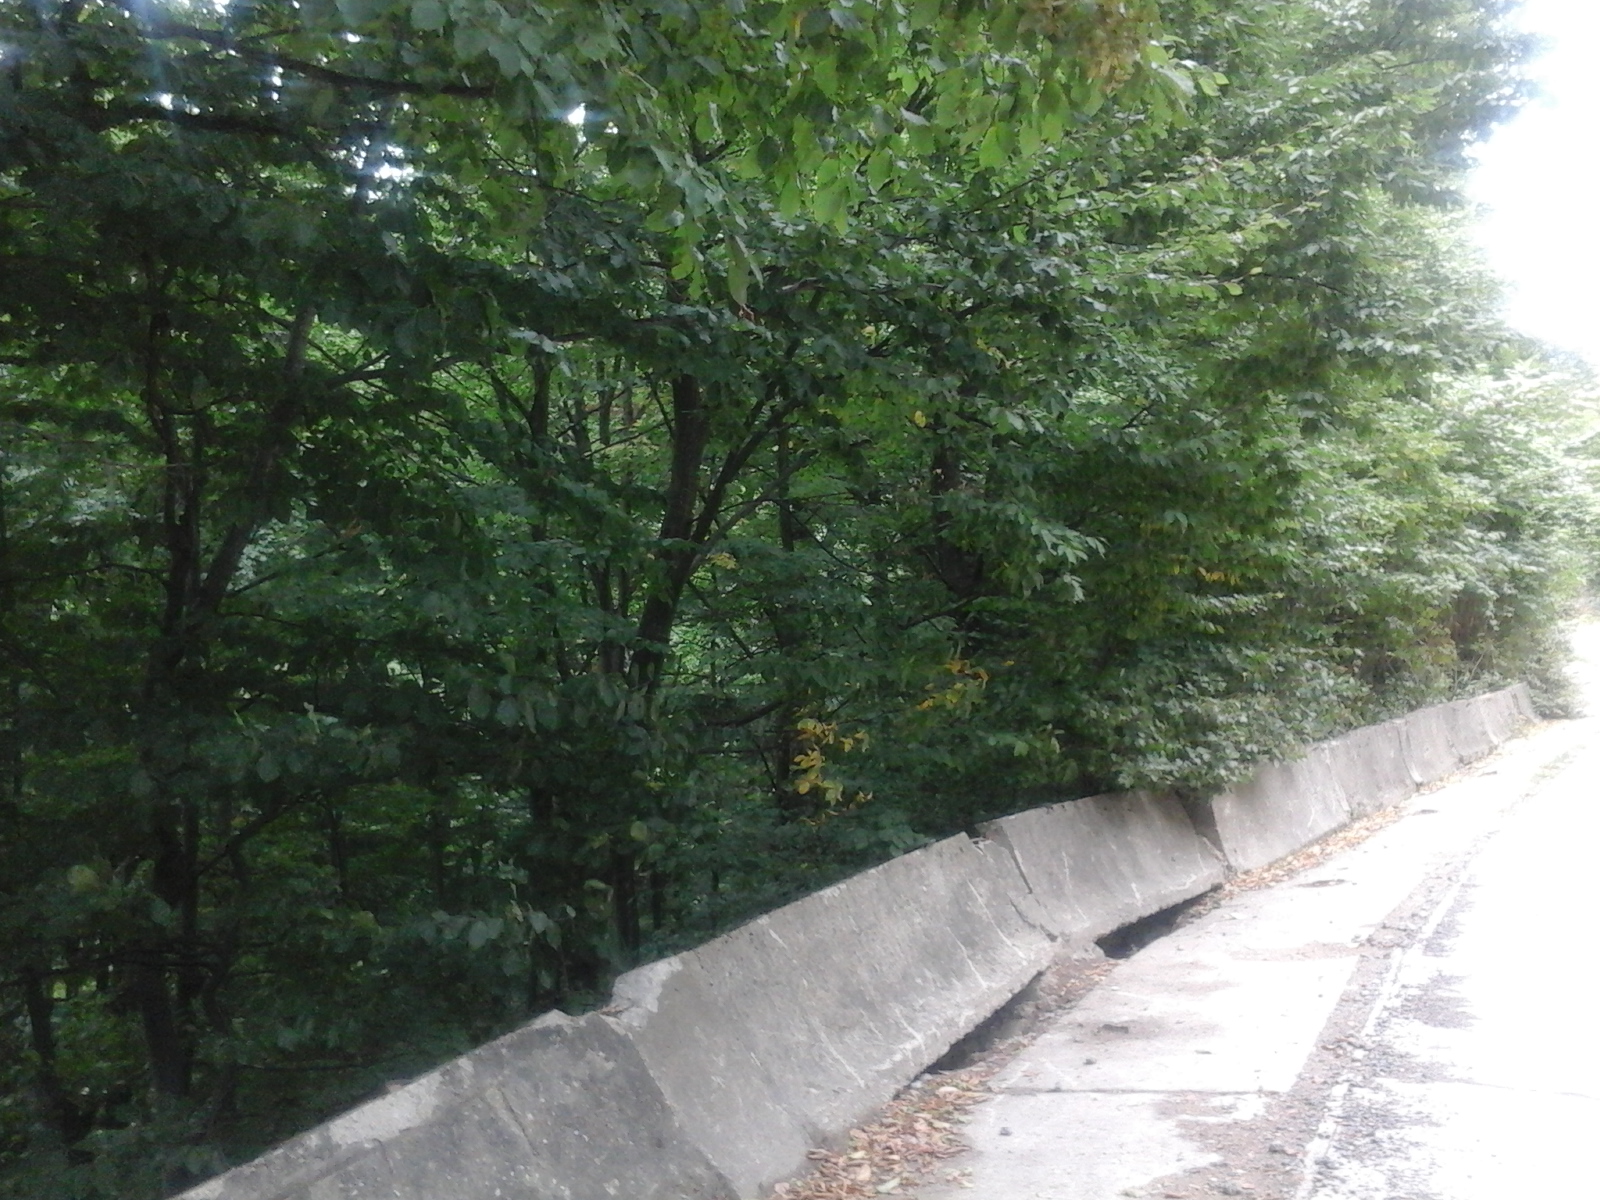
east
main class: Woodland
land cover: Broadleaved woodland
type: beech forest
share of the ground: > 75 %
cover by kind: broadleaved forest trees 100 %
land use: Forestry
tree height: > 5 m
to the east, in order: Broadleaved woodland; Other structural elements; Paved roads, cycling and walking lanes; Broadleaved woodland; Artificial constructions in urban areas
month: August
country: RO
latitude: 45.1056
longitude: 21.8666
